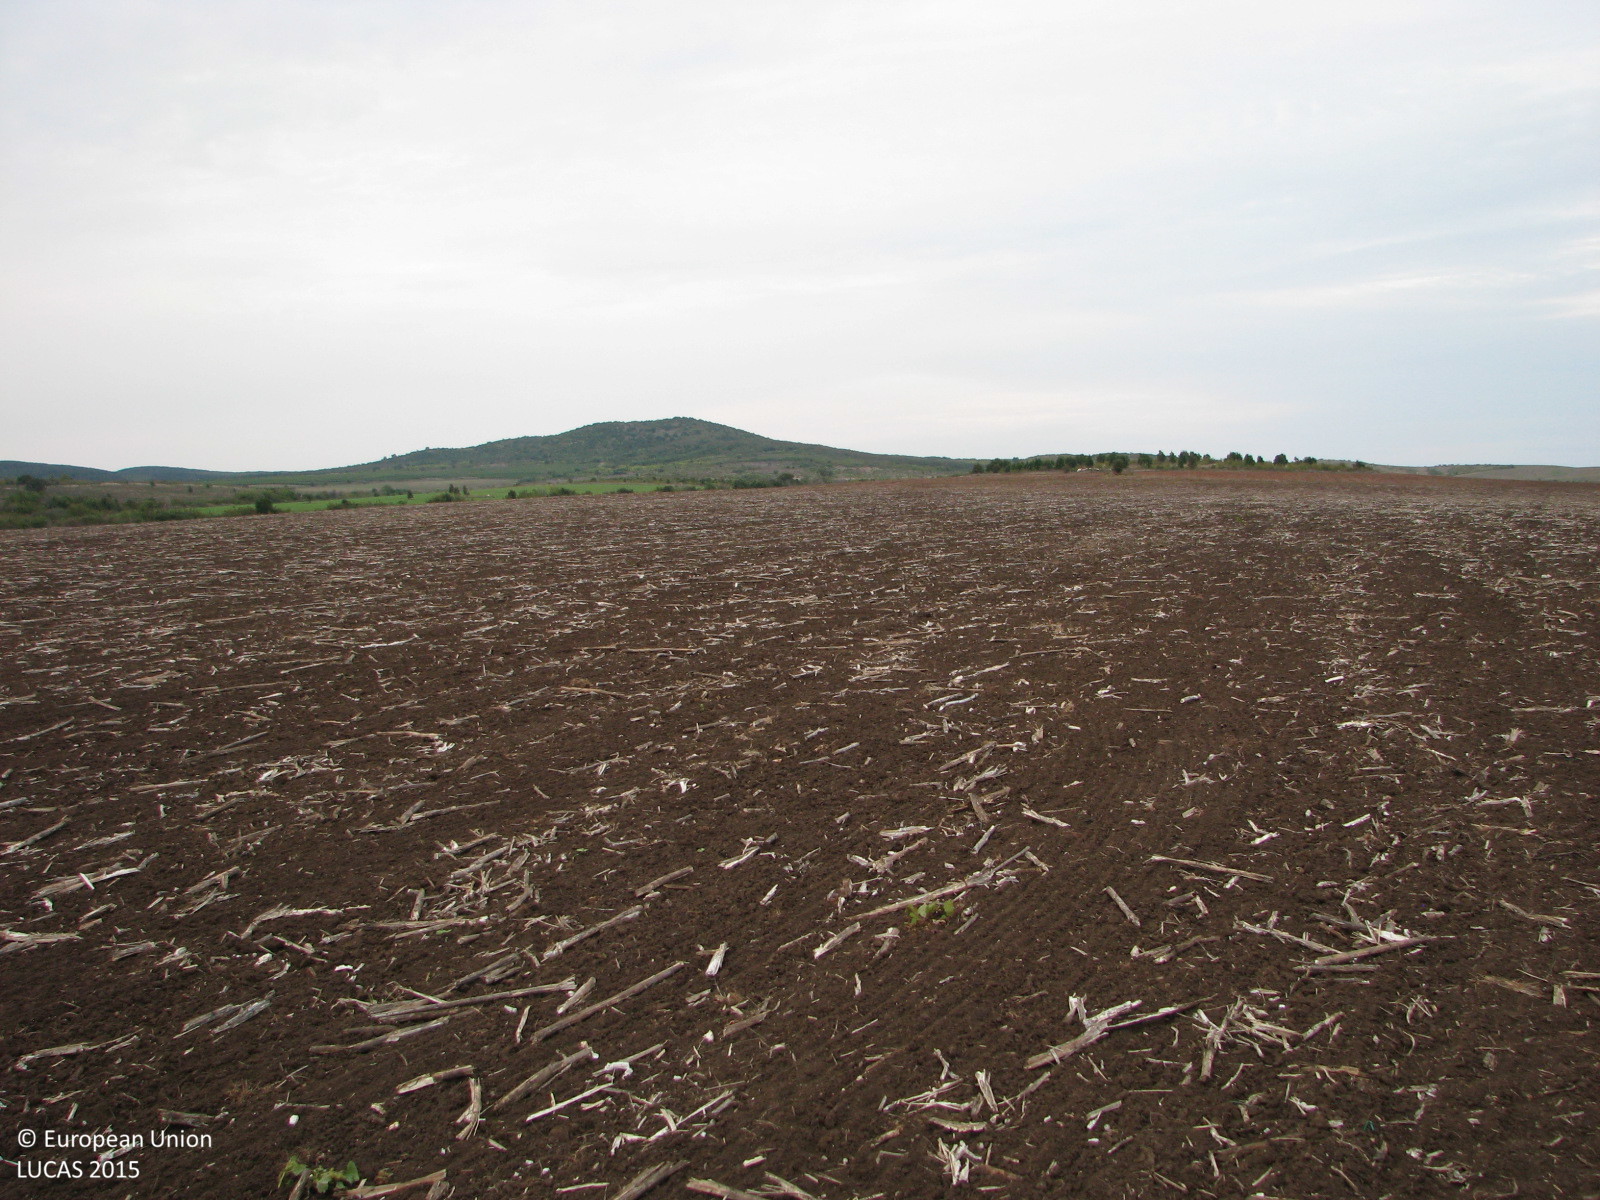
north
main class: Cropland
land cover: Sunflower
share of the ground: < 10 %
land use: Agriculture (excluding fallow land and kitchen gardens)
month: October
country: BG
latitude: 42.3909
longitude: 26.1788
